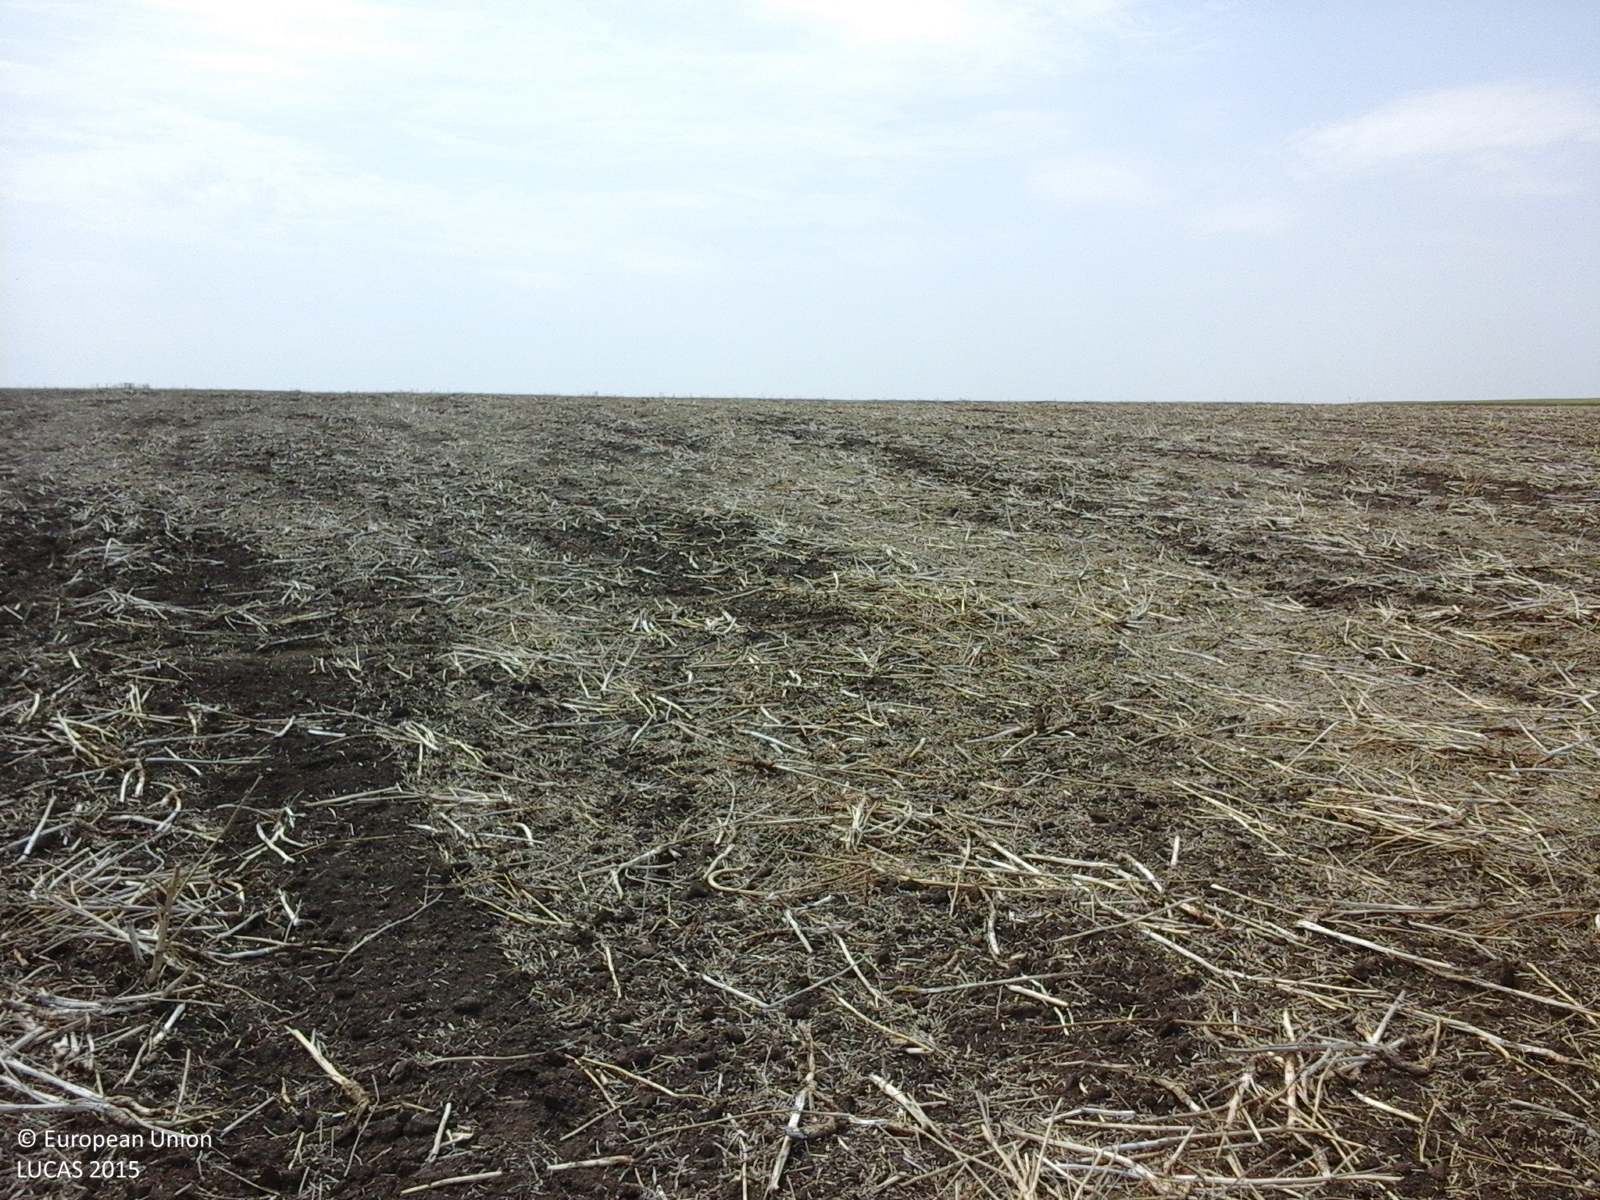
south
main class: Cropland
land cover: Rape and turnip rape
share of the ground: 10 - 25 %
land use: Agriculture (excluding fallow land and kitchen gardens)
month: August
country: RO
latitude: 43.9665
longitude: 28.3728
